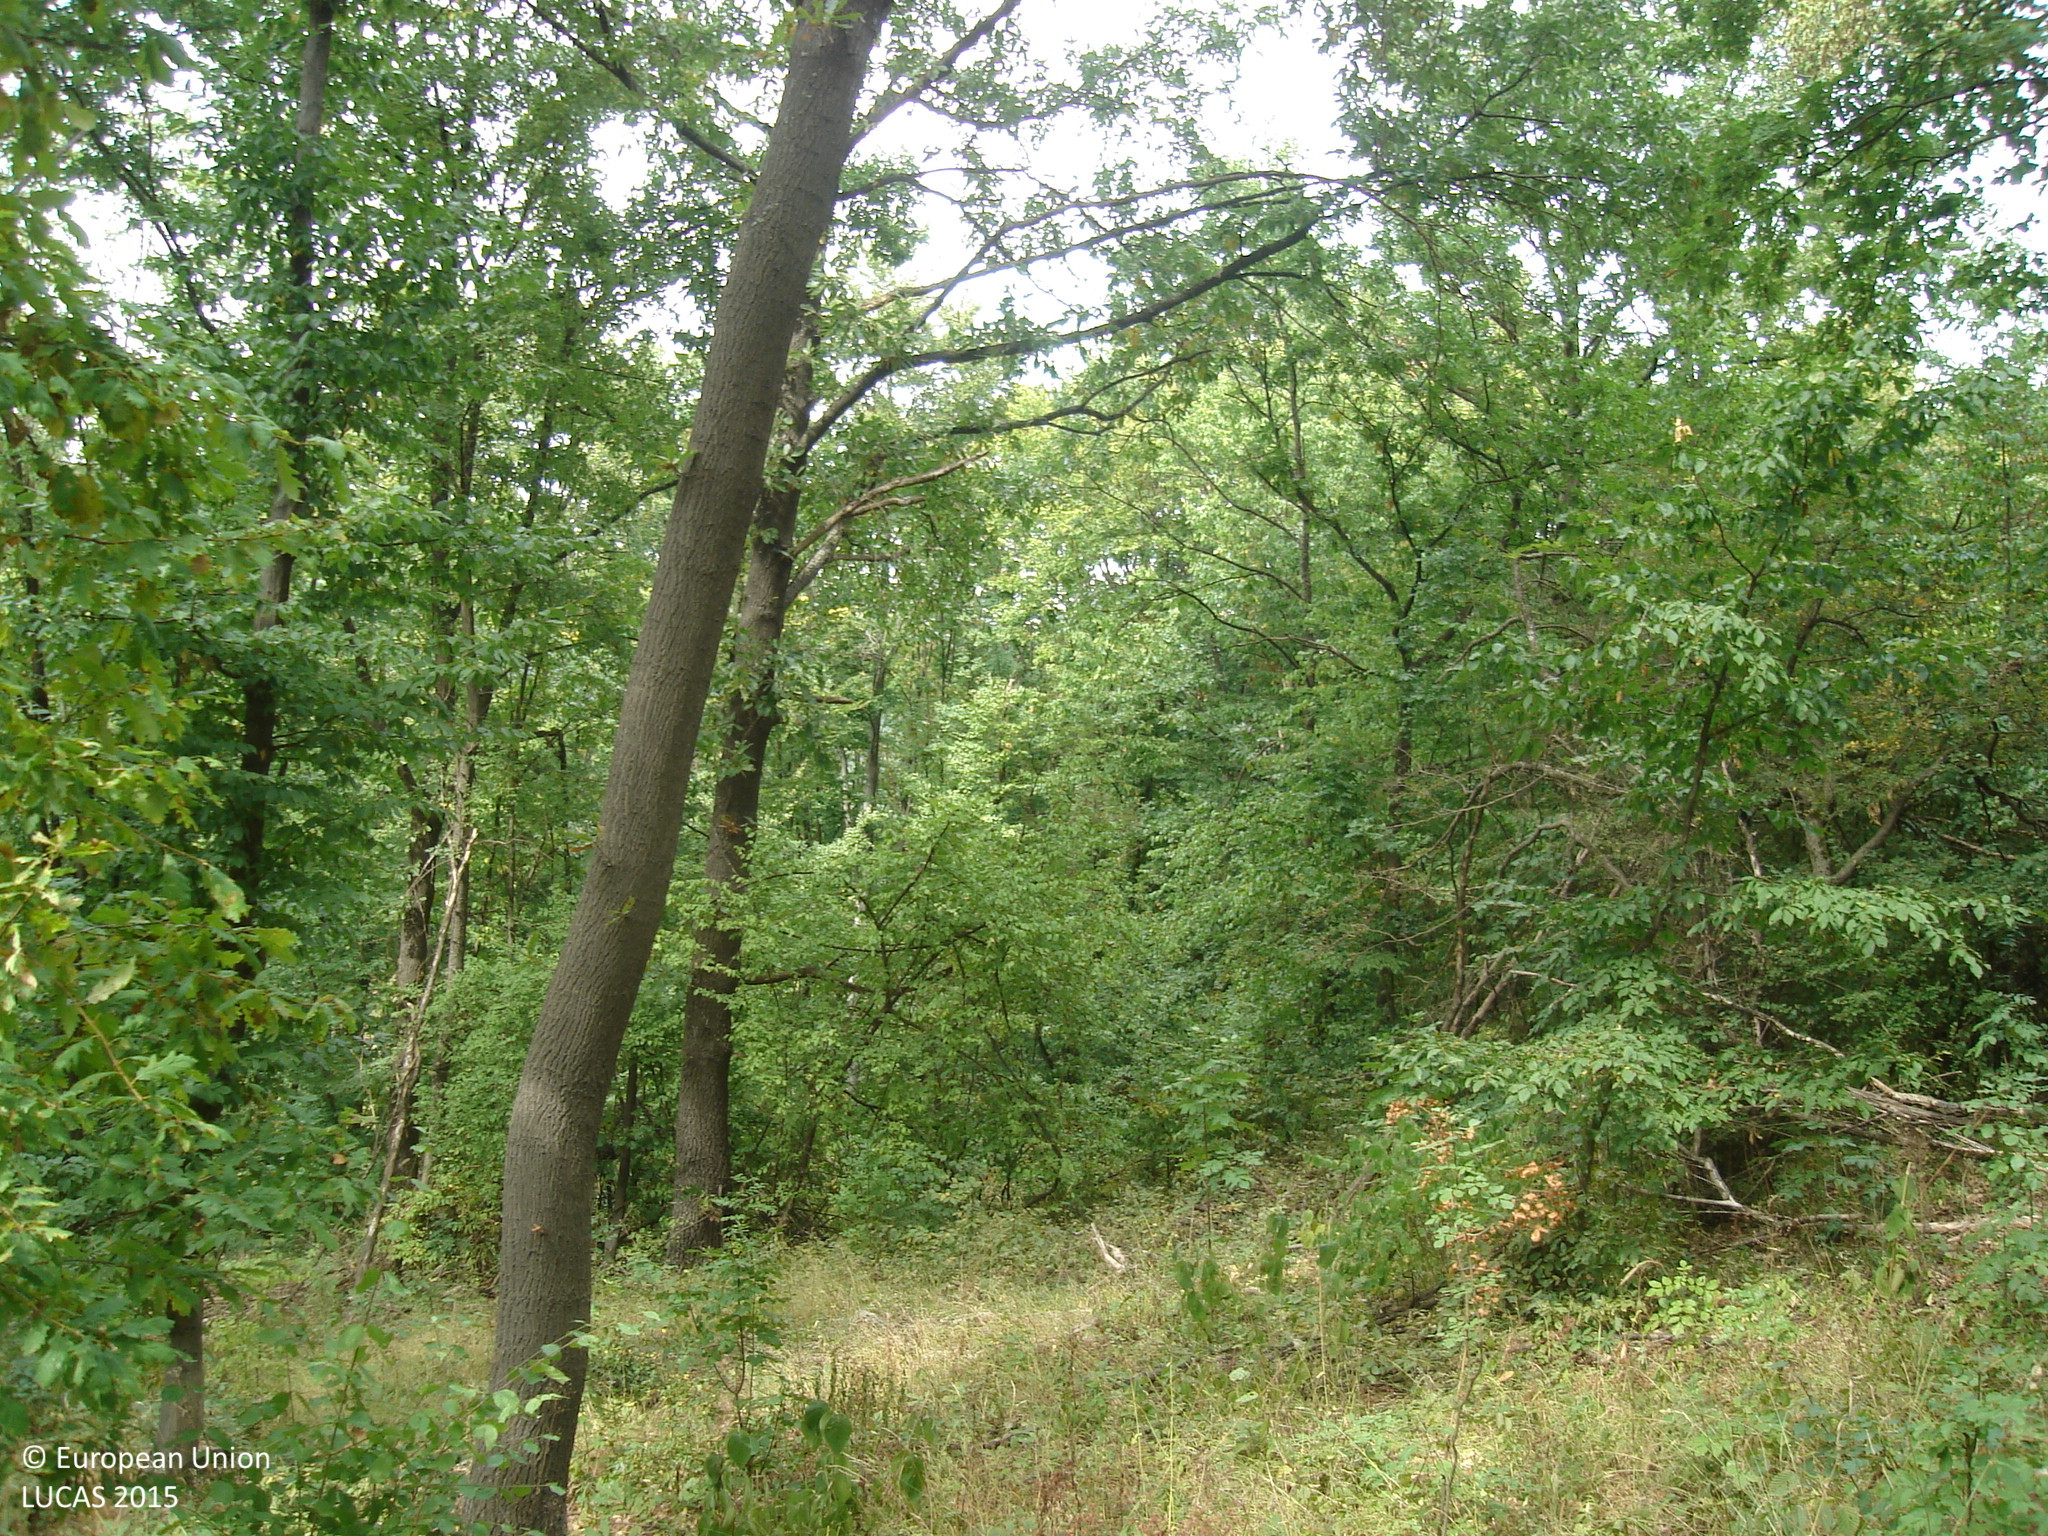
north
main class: Woodland
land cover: Broadleaved woodland
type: acidophilous oak and oak-birch forest
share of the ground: 50 - 75 %
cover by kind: broadleaved forest trees 60 %, shrubs 20 %, herbaceous plants 20 %
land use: Forestry
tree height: > 5 m
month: September
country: BG
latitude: 42.6438
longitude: 23.8853
